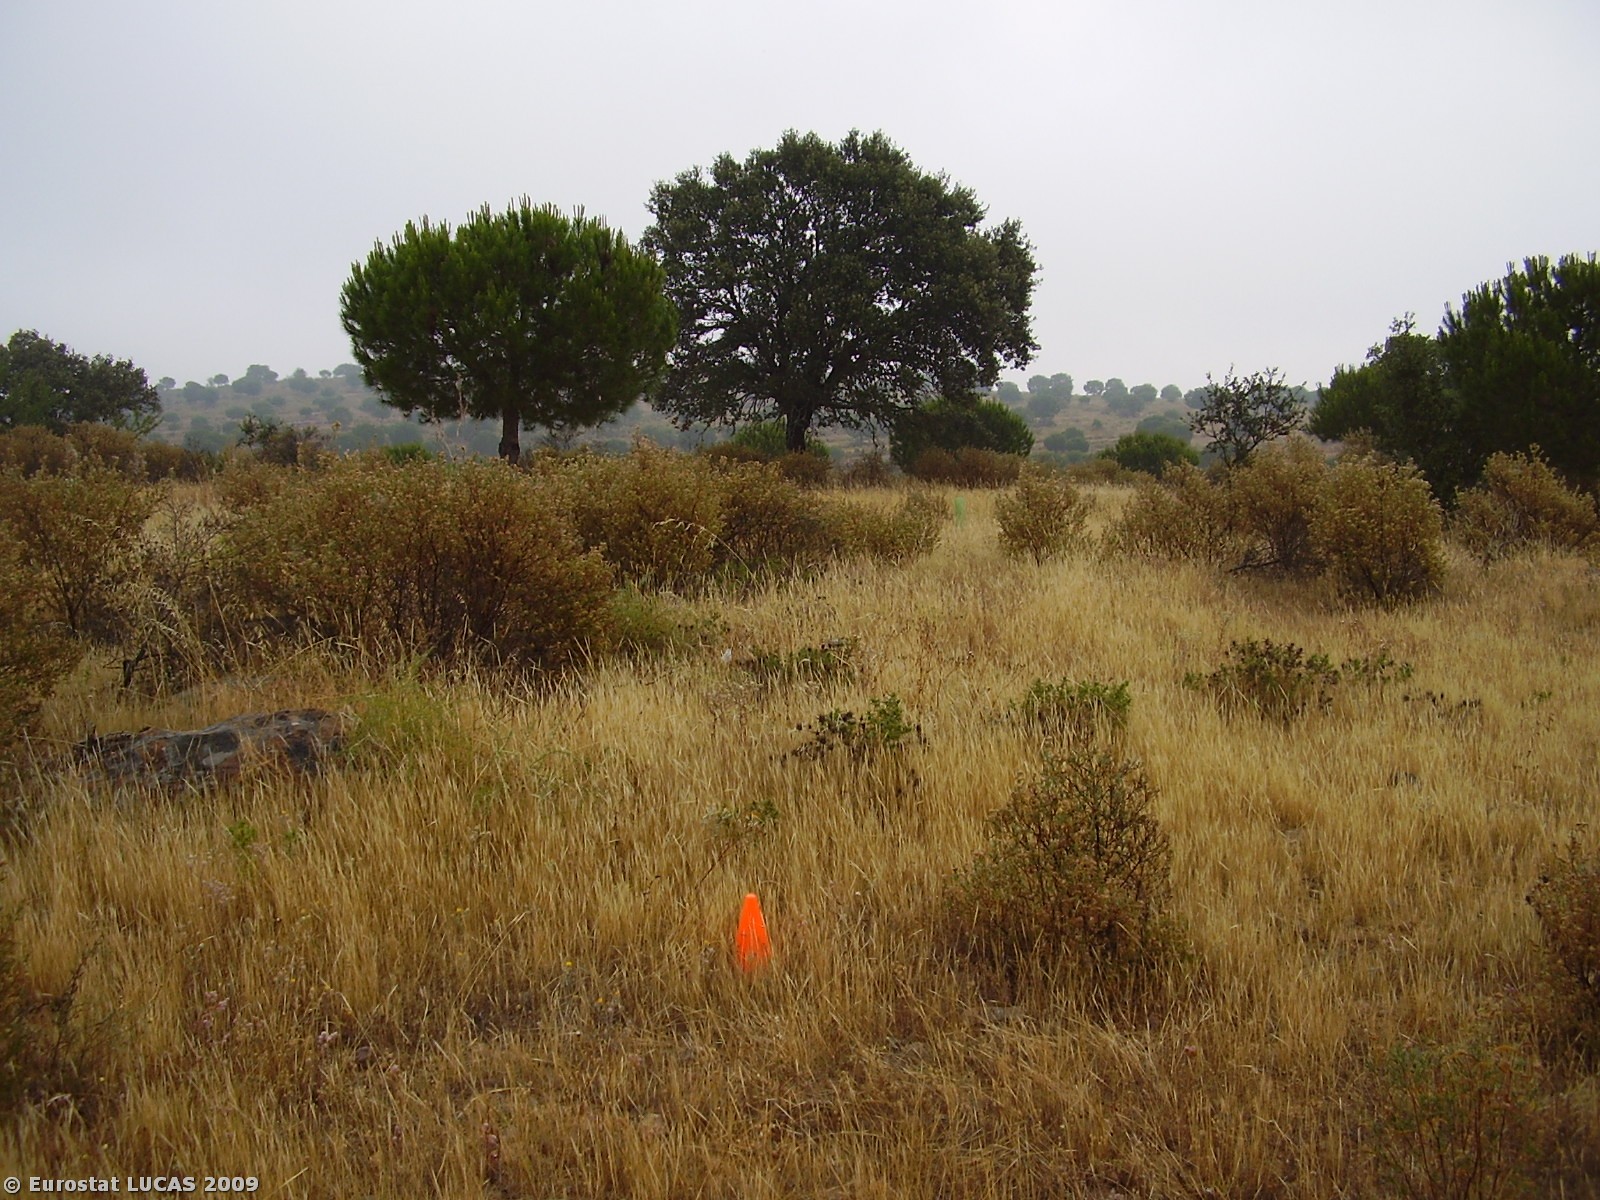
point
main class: Woodland
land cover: Mixed woodland
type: coniferous forest of the mediterranean region
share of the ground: 25 - 50 %
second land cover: Spontaneously vegetated surfaces
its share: 50 - 75 %
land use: Forestry
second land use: Fallow land
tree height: > 5 m
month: May
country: PT
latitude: 37.6160
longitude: -7.5617
